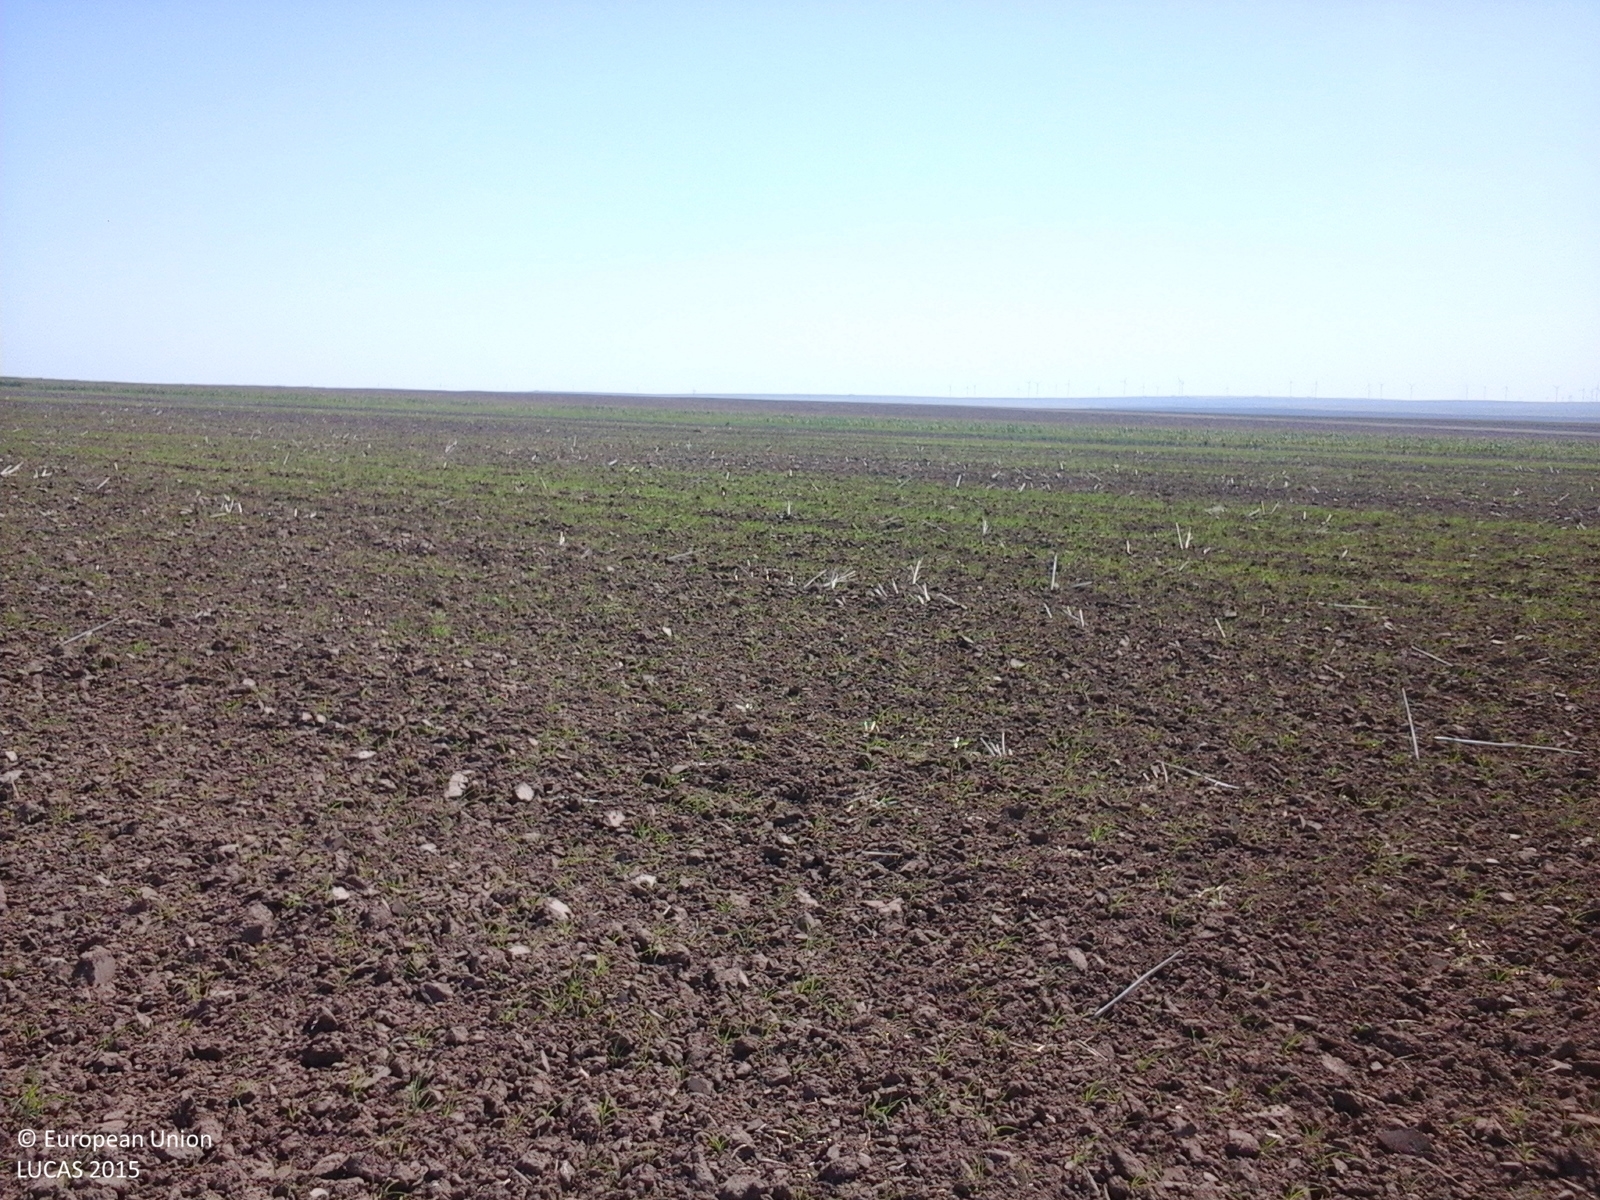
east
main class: Cropland
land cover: Rape and turnip rape
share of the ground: < 10 %
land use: Agriculture (excluding fallow land and kitchen gardens)
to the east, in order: Rape and turnip rape; Lucerne
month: August
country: RO
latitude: 44.6595
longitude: 28.1091
